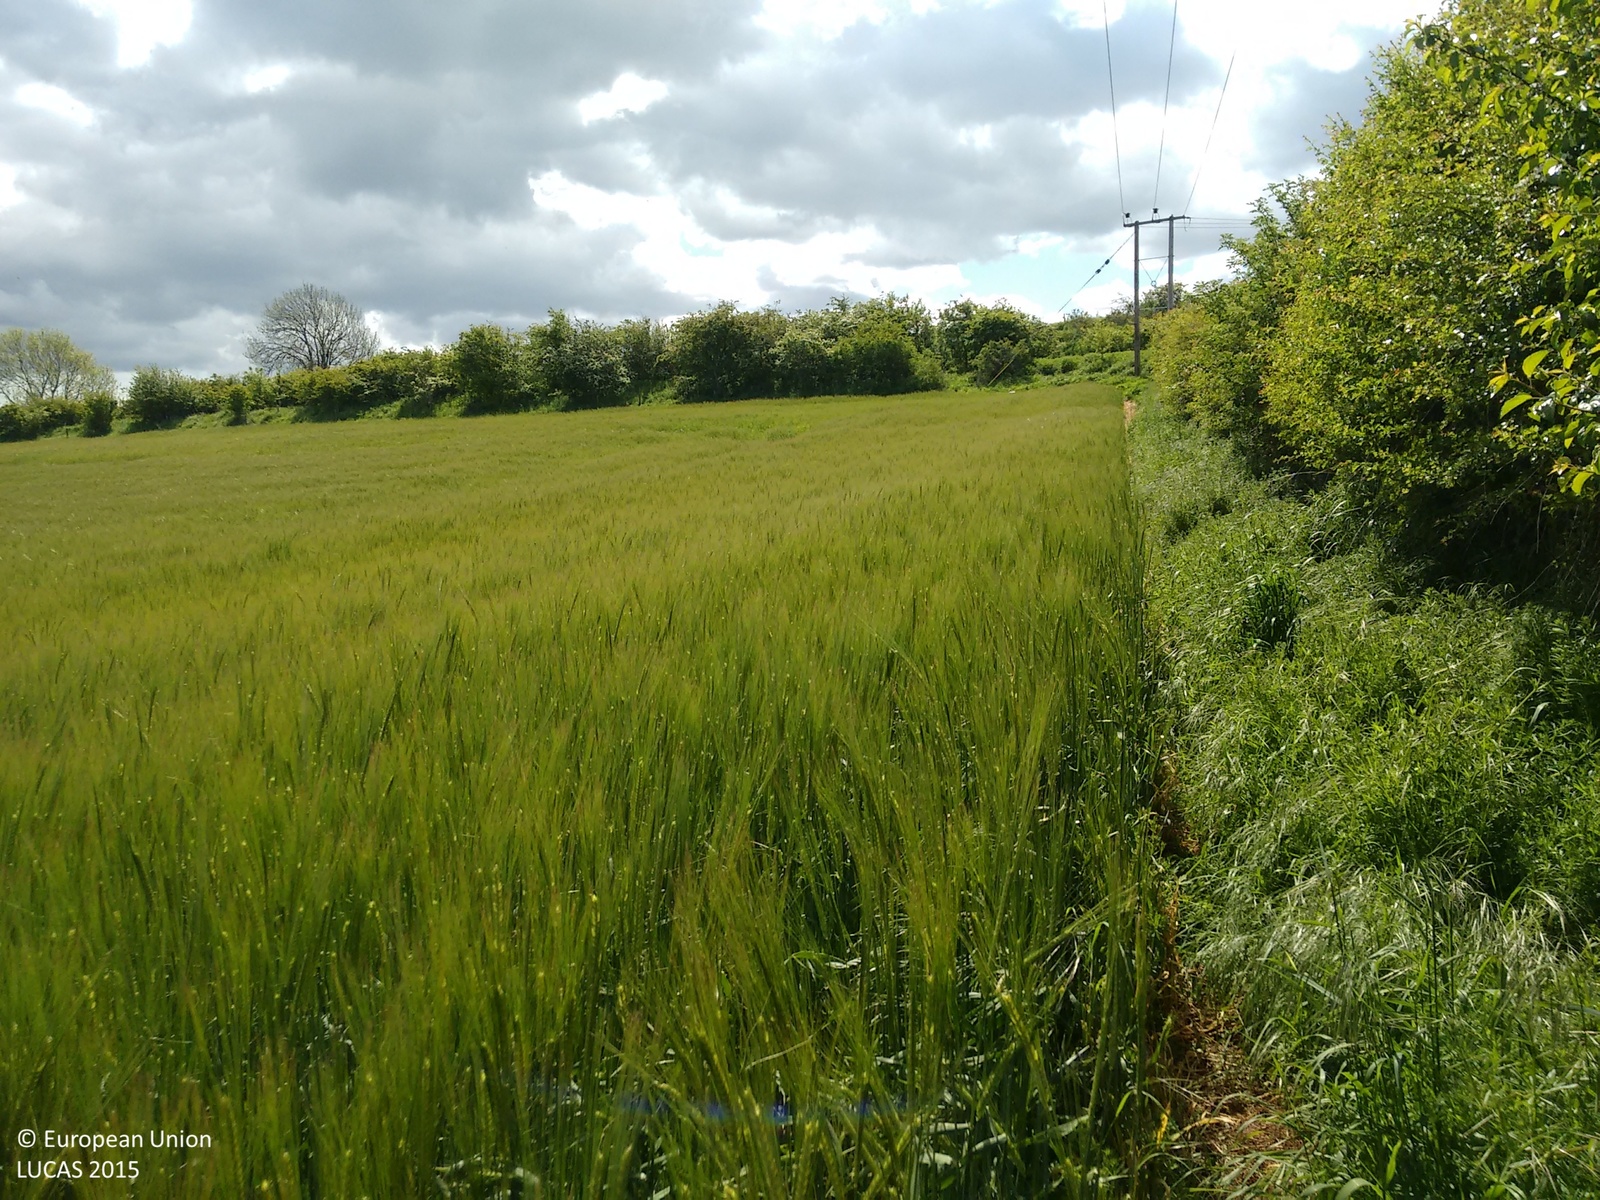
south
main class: Cropland
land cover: Barley
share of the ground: > 75 %
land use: Agriculture (excluding fallow land and kitchen gardens)
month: June
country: GB
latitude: 55.6324
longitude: -2.2717
